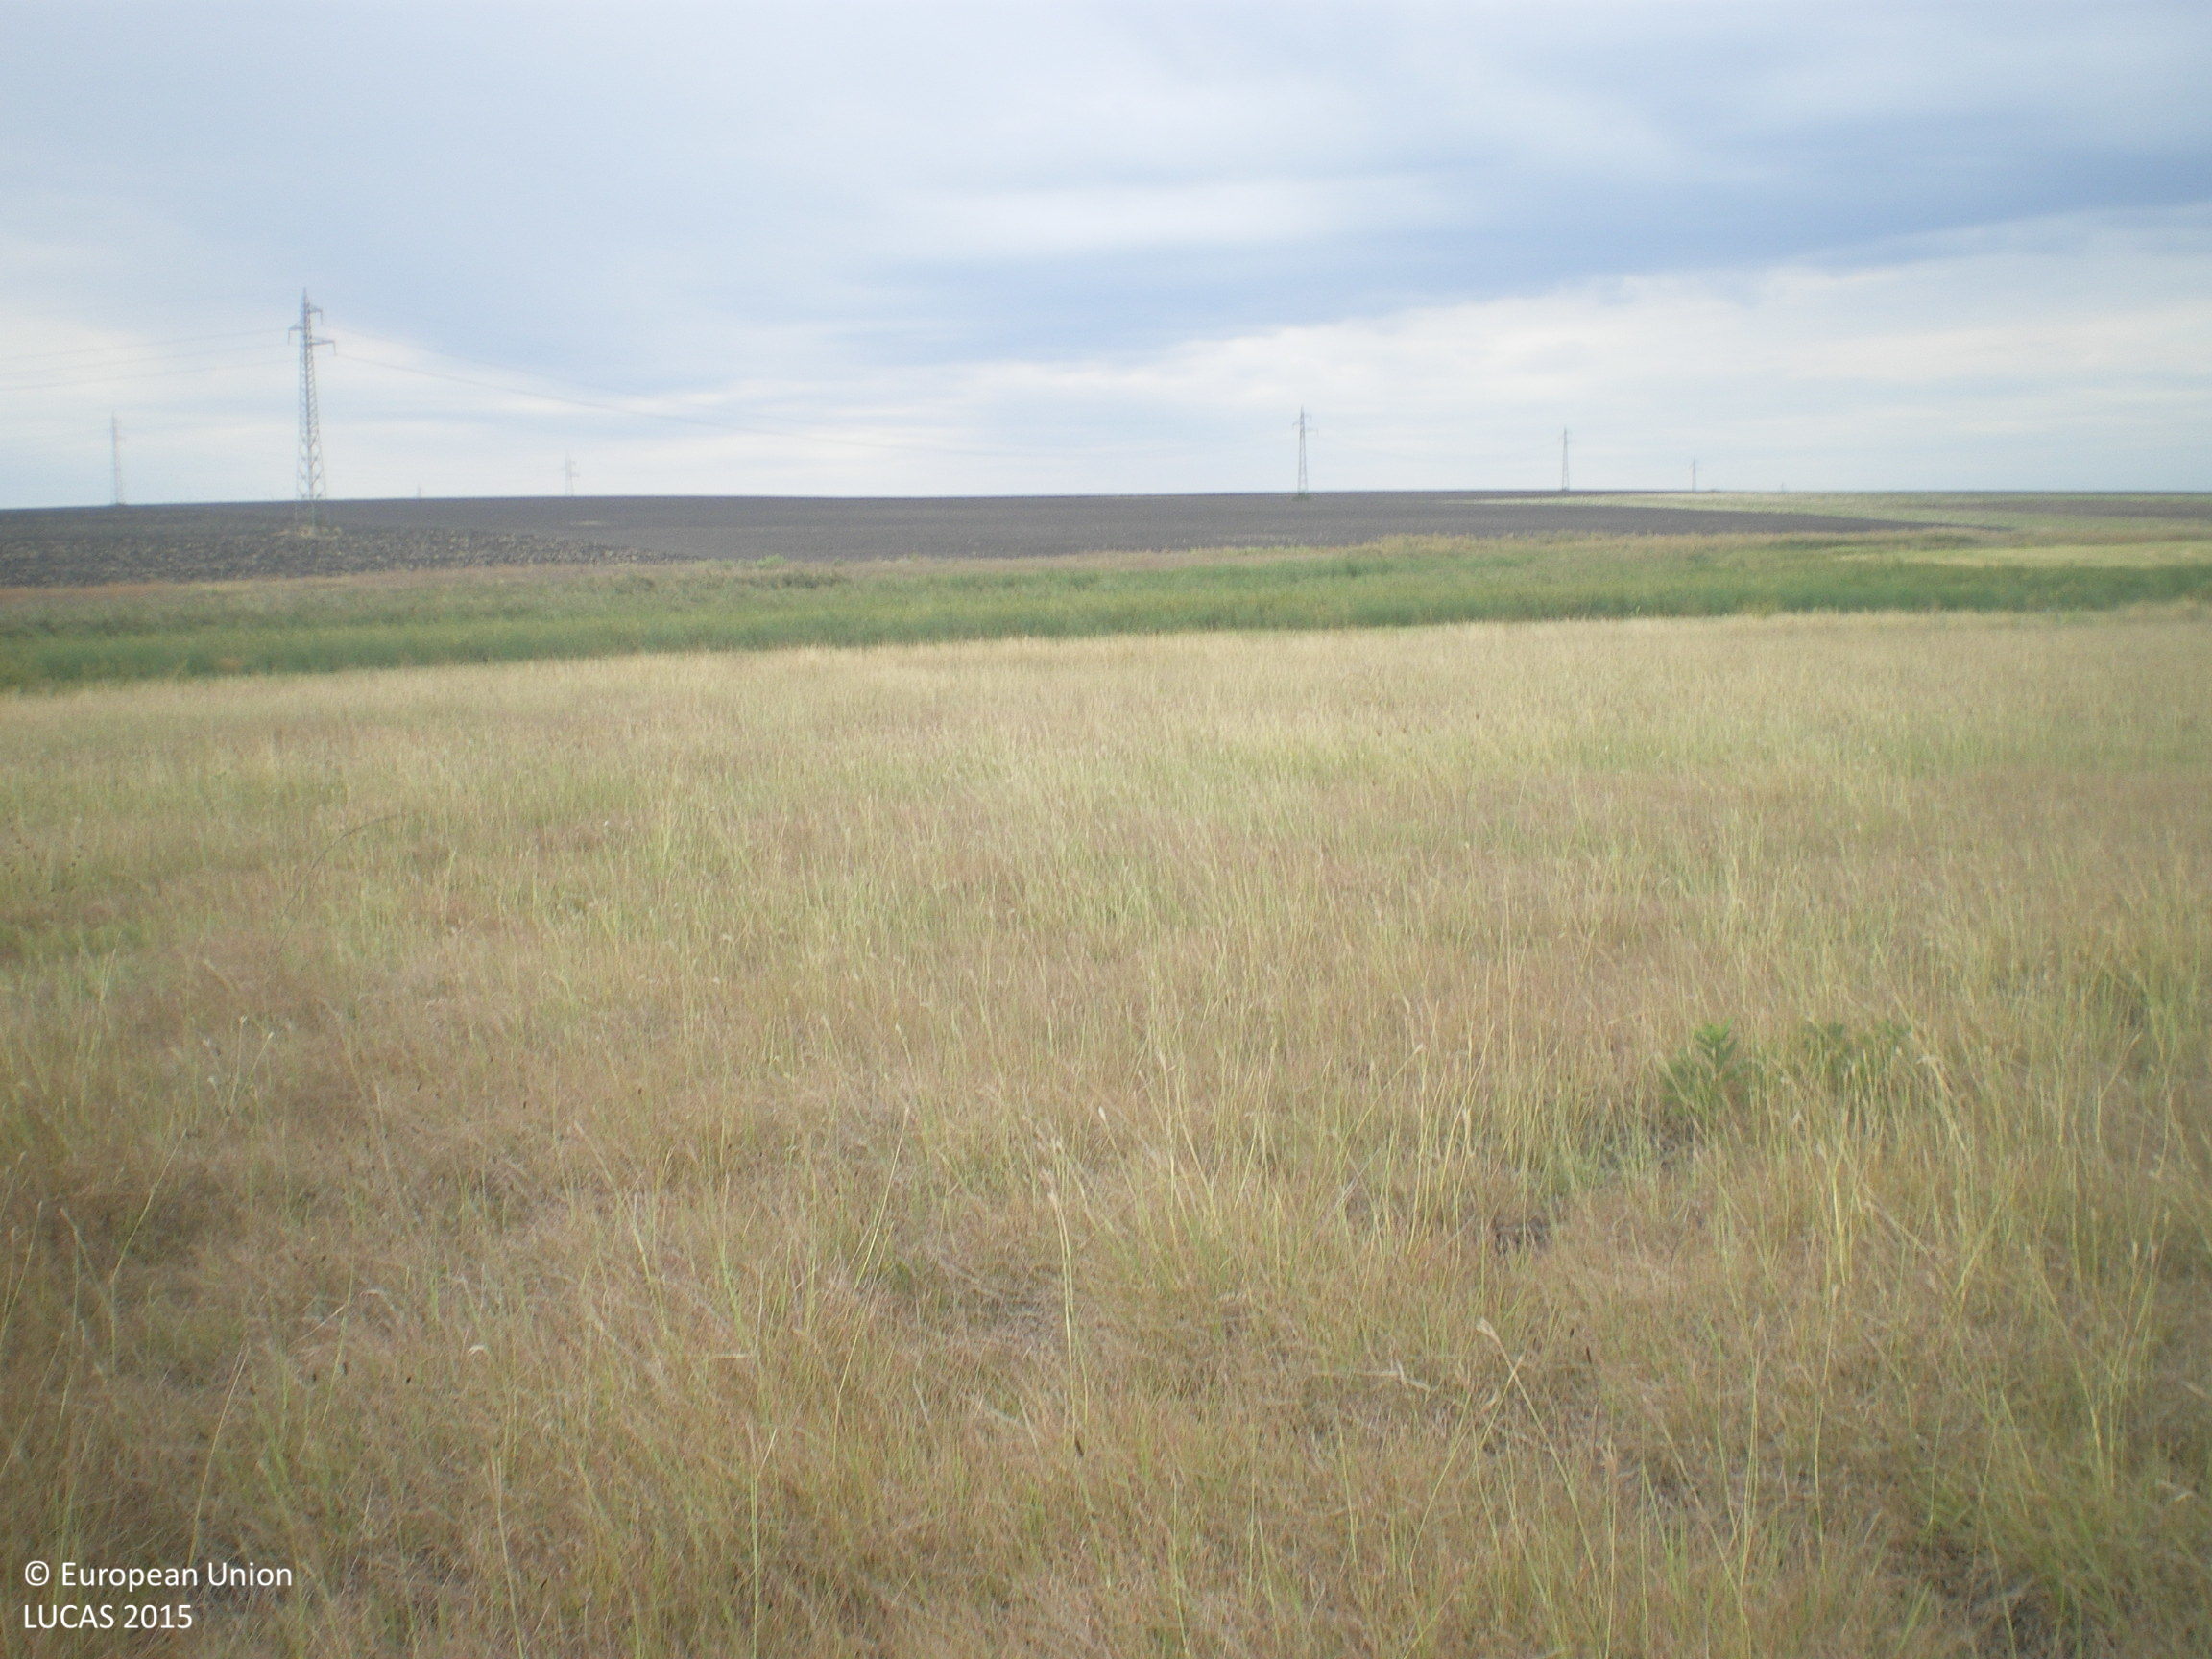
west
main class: Grassland
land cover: Grassland with sparse tree/shrub cover
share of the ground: > 75 %
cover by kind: herbaceous plants 90 %, broadleaved forest trees 5 %, shrubs 5 %
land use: Semi-natural and natural areas not in use
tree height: > 5 m
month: September
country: BG
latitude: 42.2594
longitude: 25.9692
